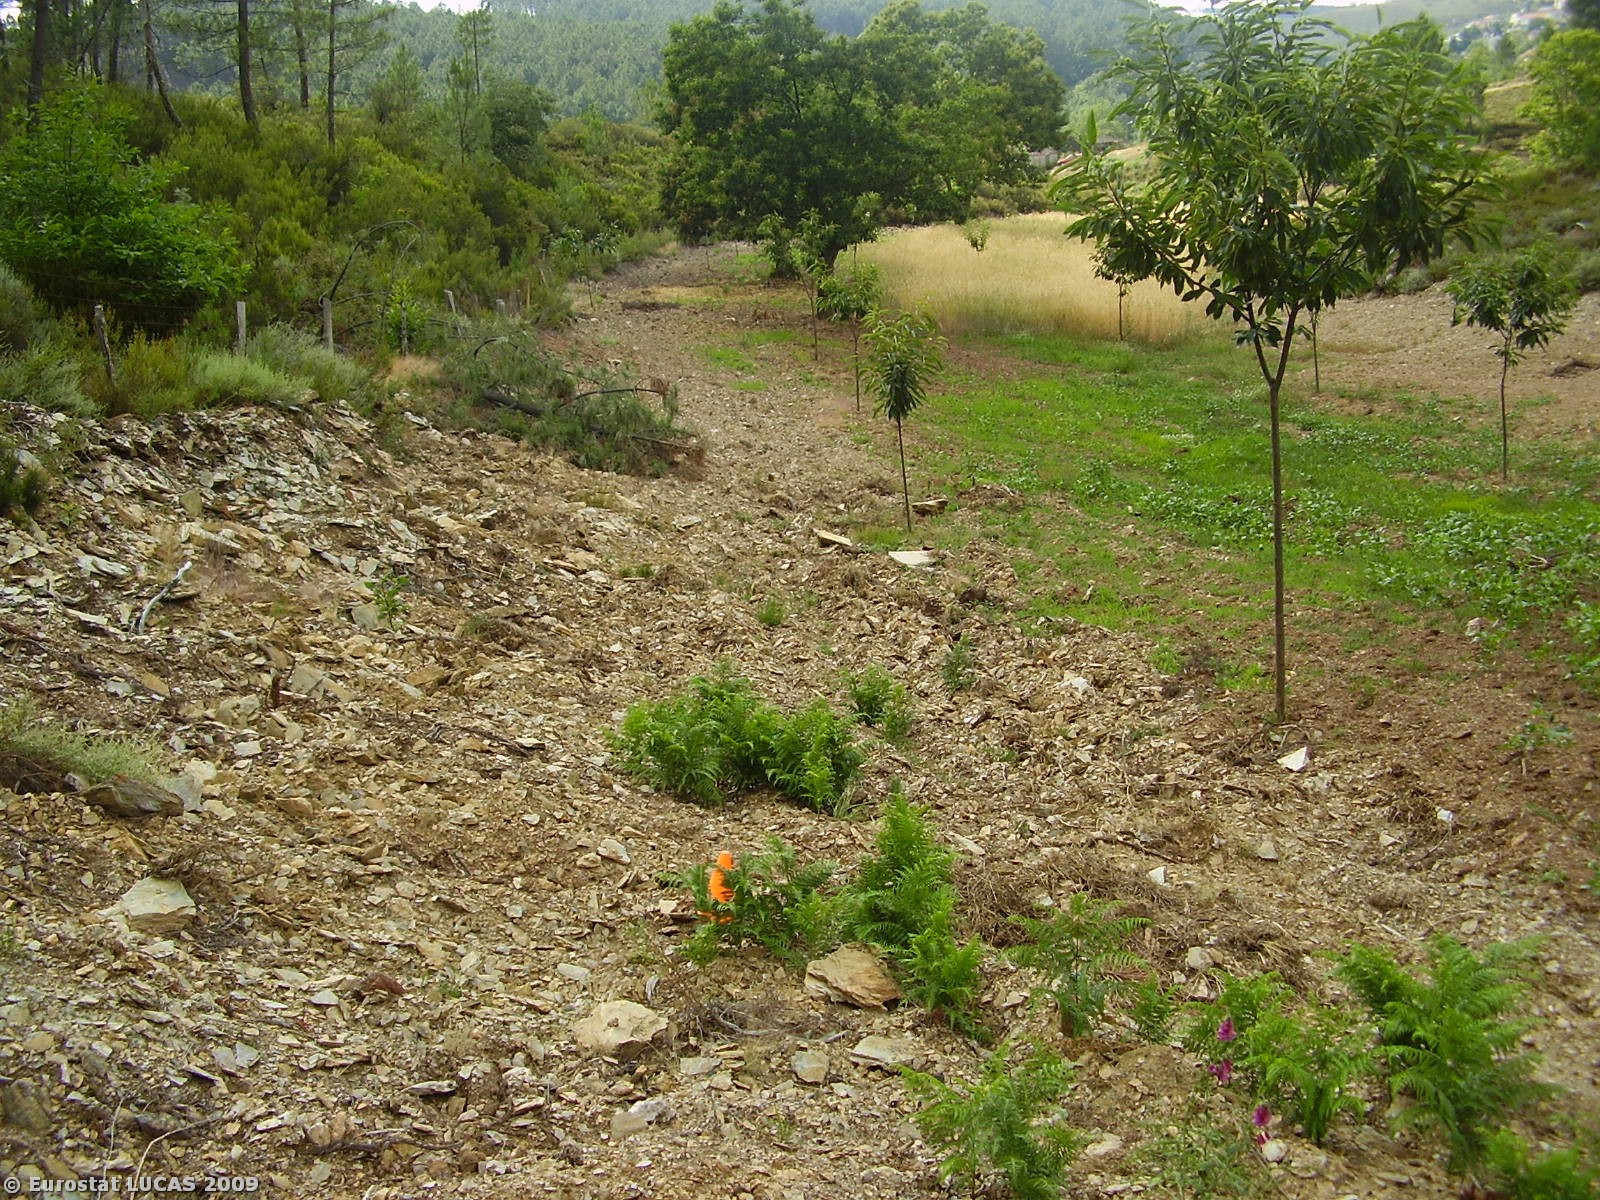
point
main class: Cropland
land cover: Nuts trees
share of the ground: < 10 %
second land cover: Bare land
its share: < 10 %
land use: Agriculture (excluding fallow land and kitchen gardens)
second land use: Unused
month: July
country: PT
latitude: 41.4935
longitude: -7.5570
